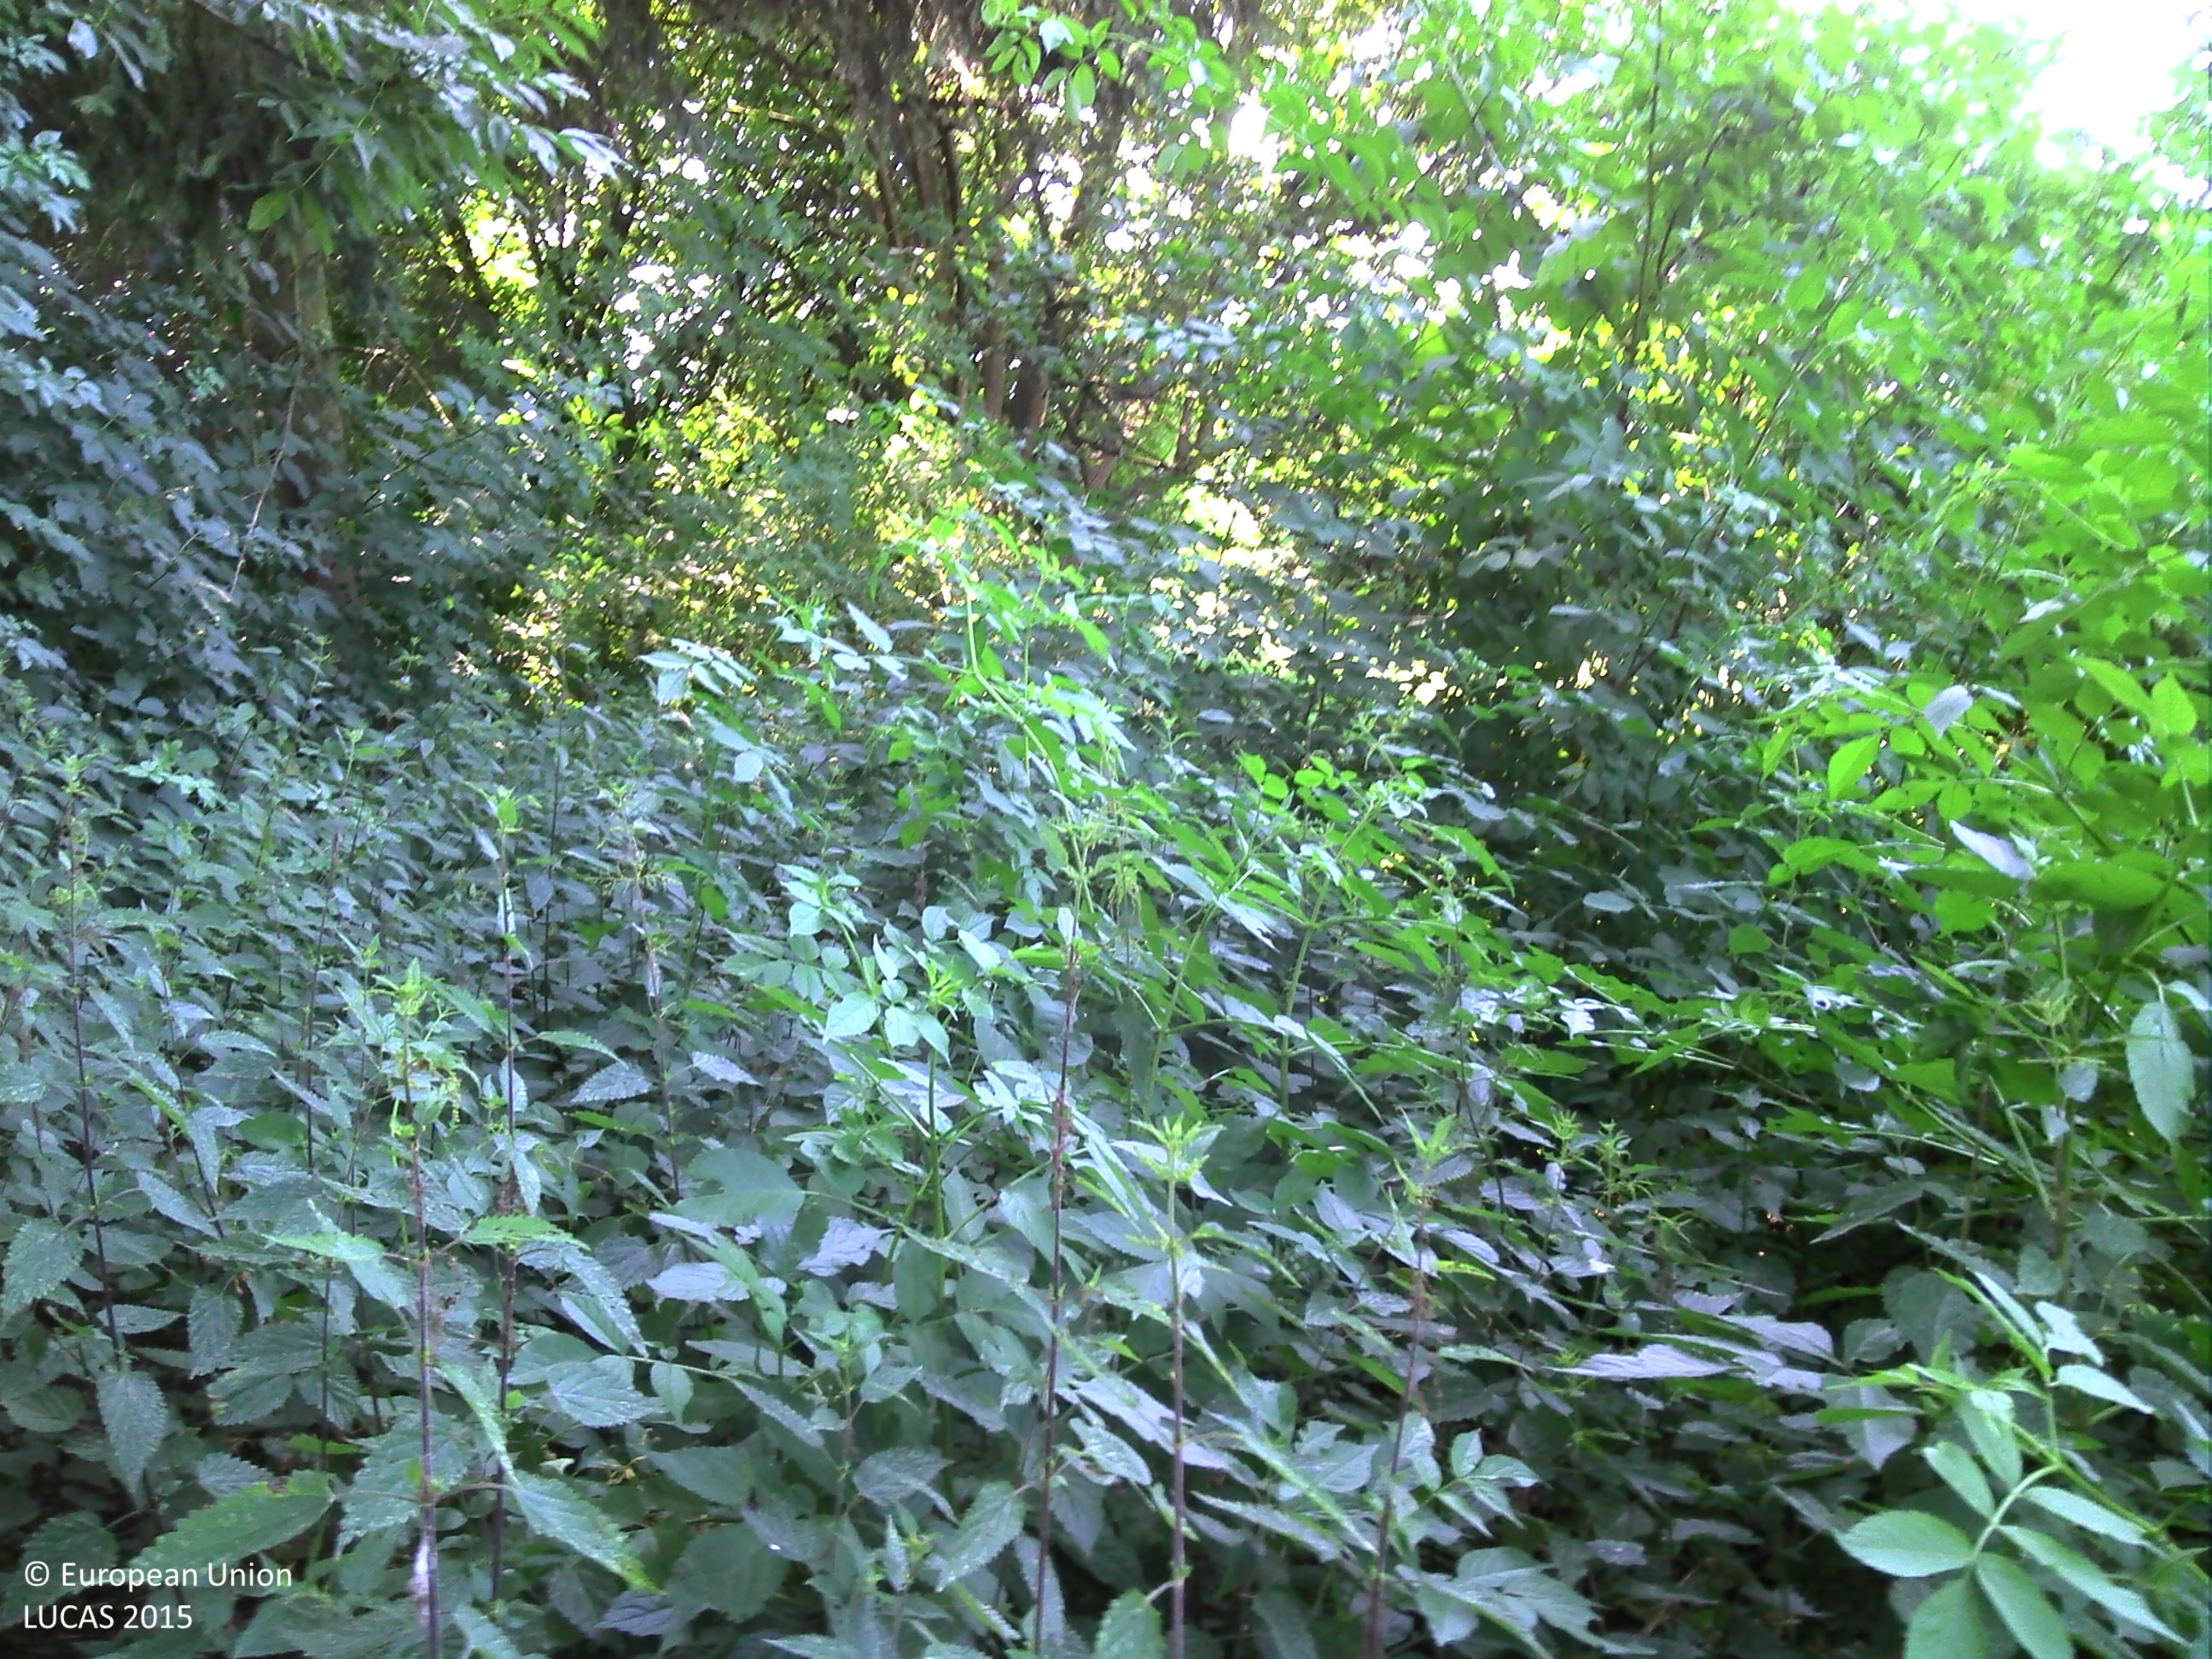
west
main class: Woodland
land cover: Broadleaved woodland
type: mesophytic deciduous forest
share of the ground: > 75 %
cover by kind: broadleaved forest trees 80 %, coniferous forest trees 20 %
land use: Semi-natural and natural areas not in use
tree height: > 5 m
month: July
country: BE
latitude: 50.6618
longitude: 5.7121
